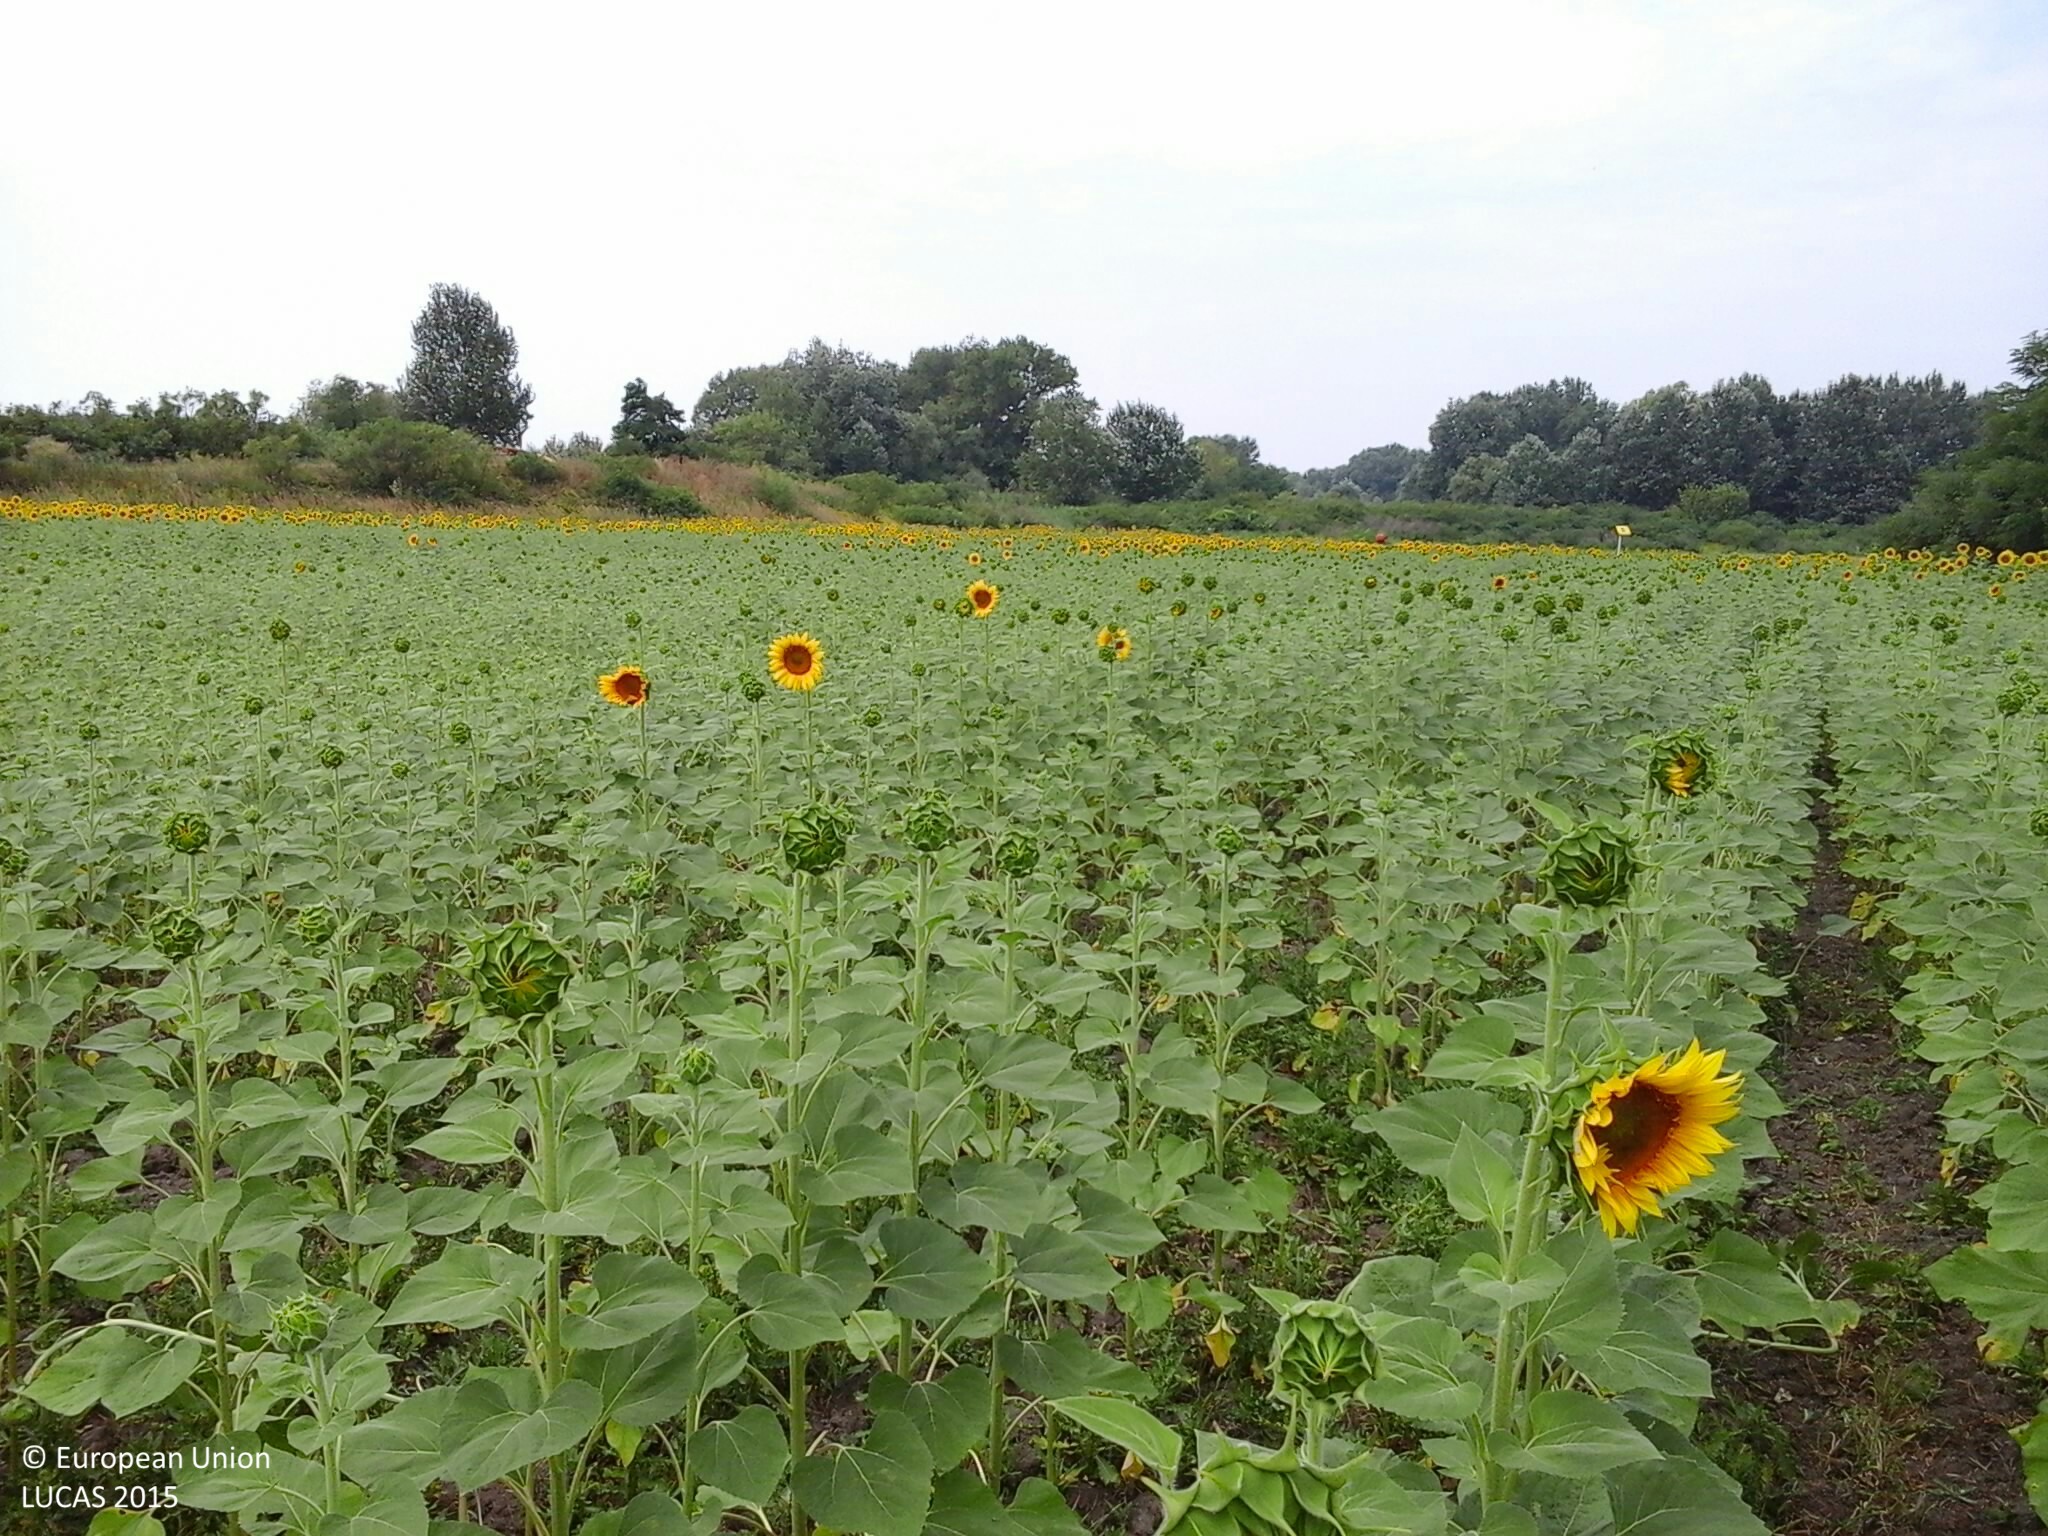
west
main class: Cropland
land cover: Sunflower
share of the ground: > 75 %
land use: Agriculture (excluding fallow land and kitchen gardens)
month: July
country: HU
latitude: 47.7754
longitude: 21.0480
